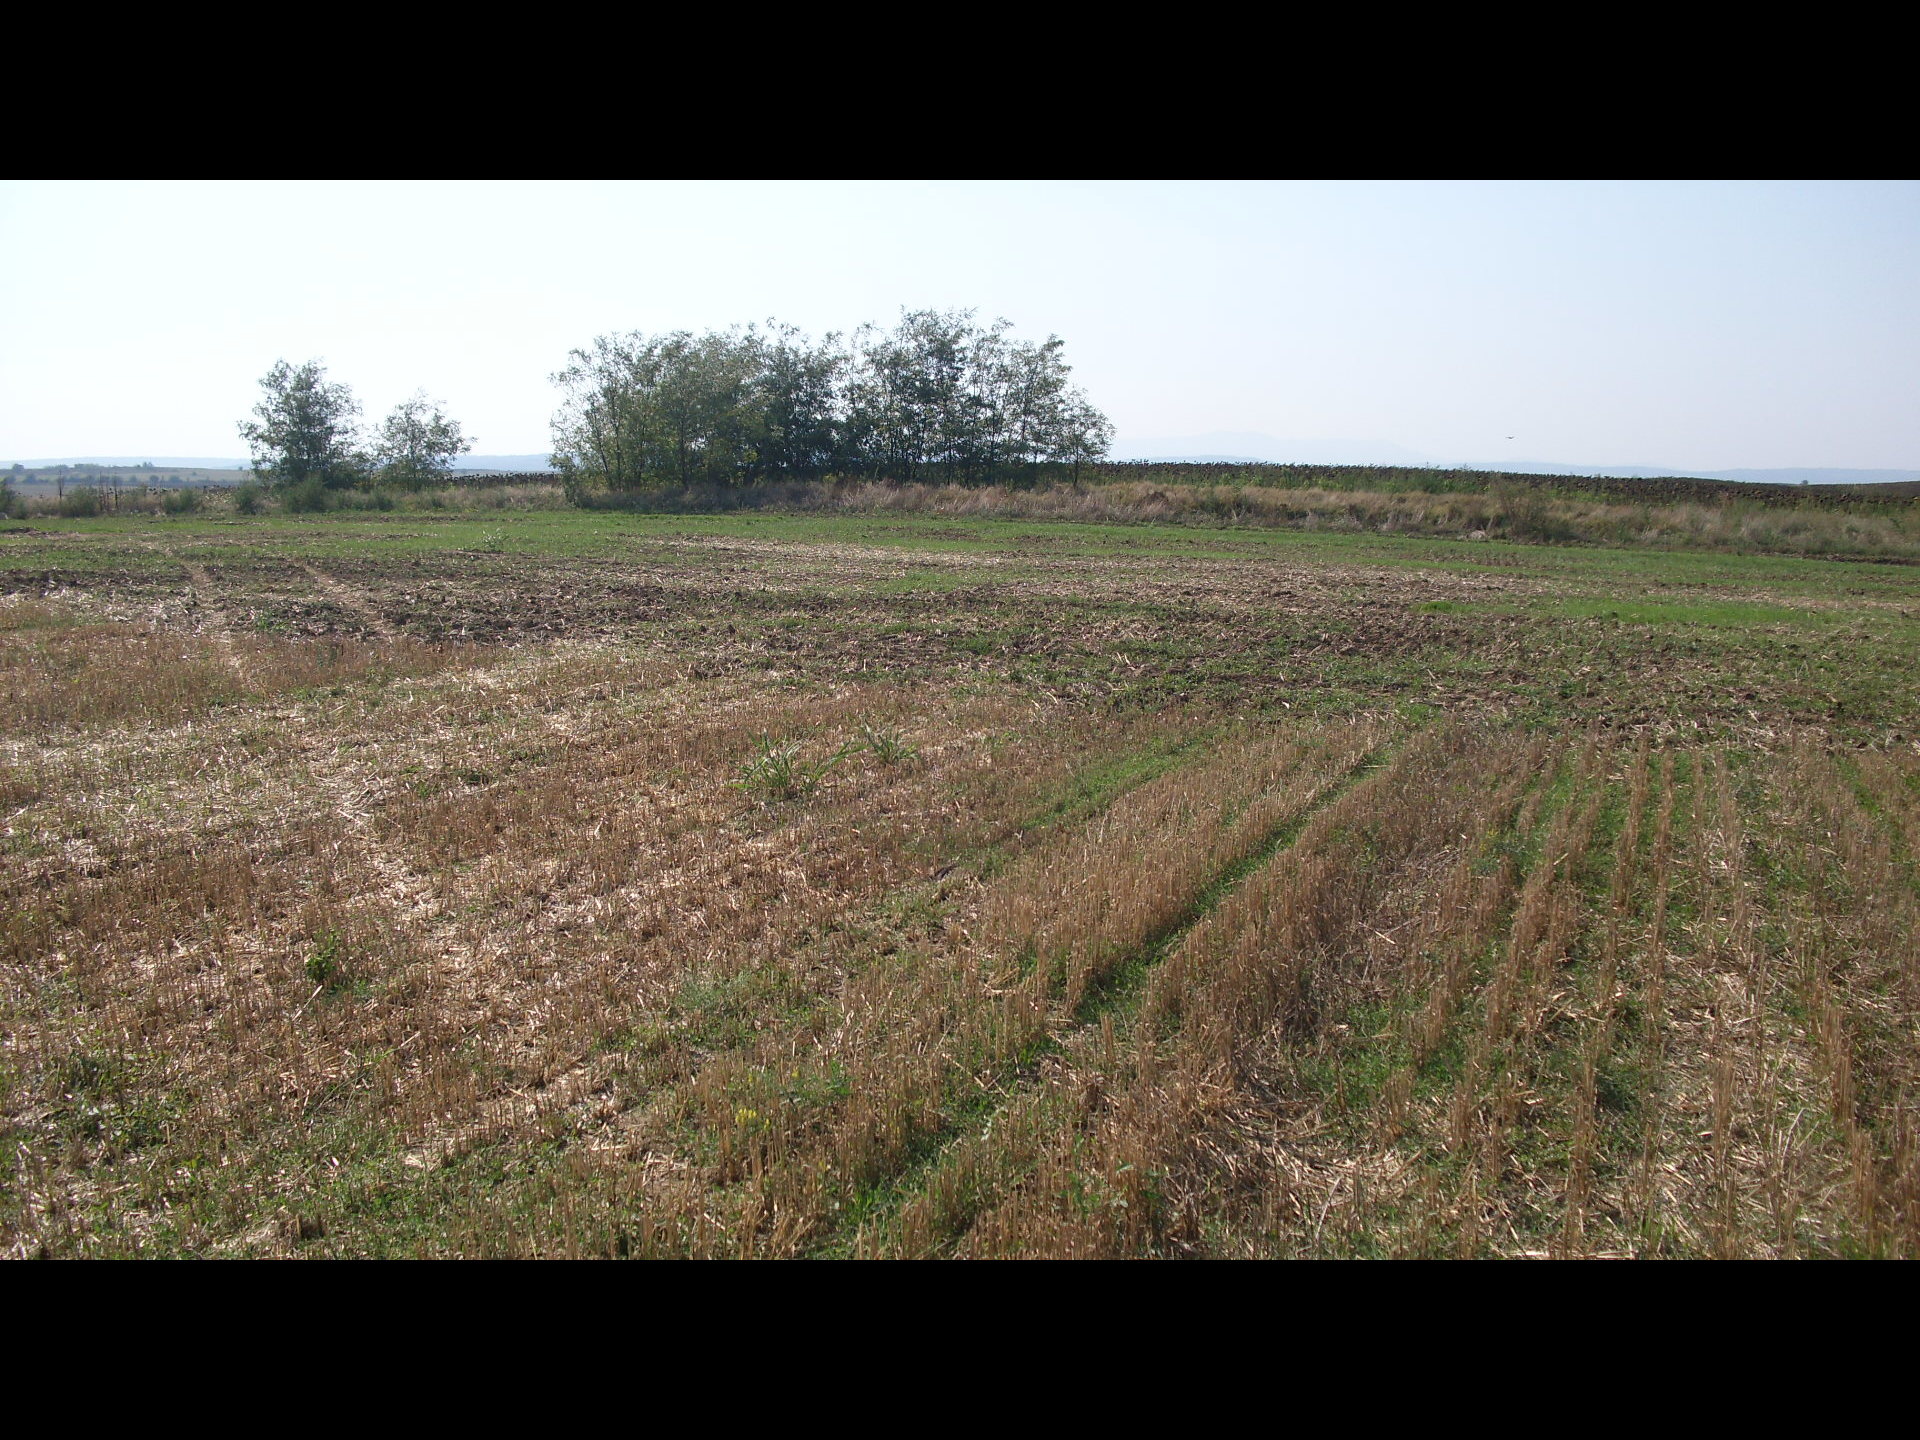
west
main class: Cropland
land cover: Common wheat
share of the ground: 50 - 75 %
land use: Agriculture (excluding fallow land and kitchen gardens)
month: August
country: BG
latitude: 44.1500
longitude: 22.7034
